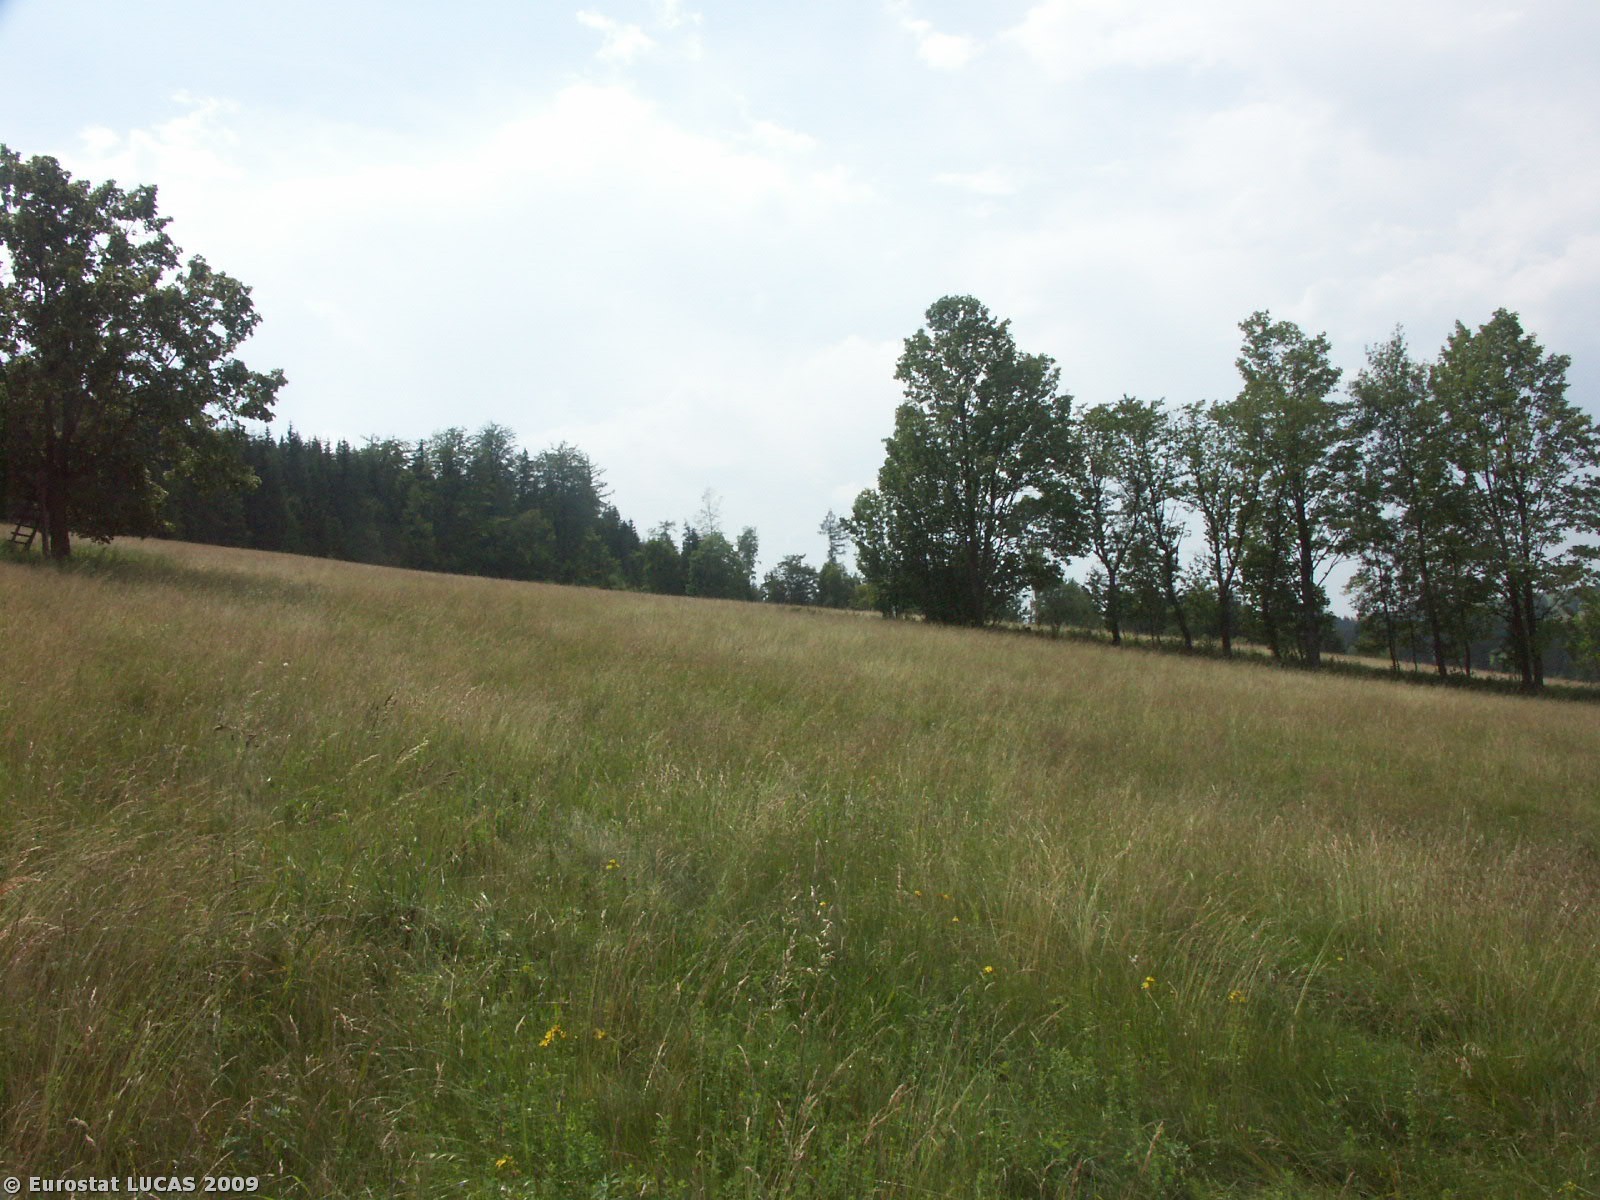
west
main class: Grassland
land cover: Grassland without tree/shrub cover
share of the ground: > 75 %
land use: Agriculture (excluding fallow land and kitchen gardens)
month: July
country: CZ
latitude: 50.0252
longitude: 16.6664
